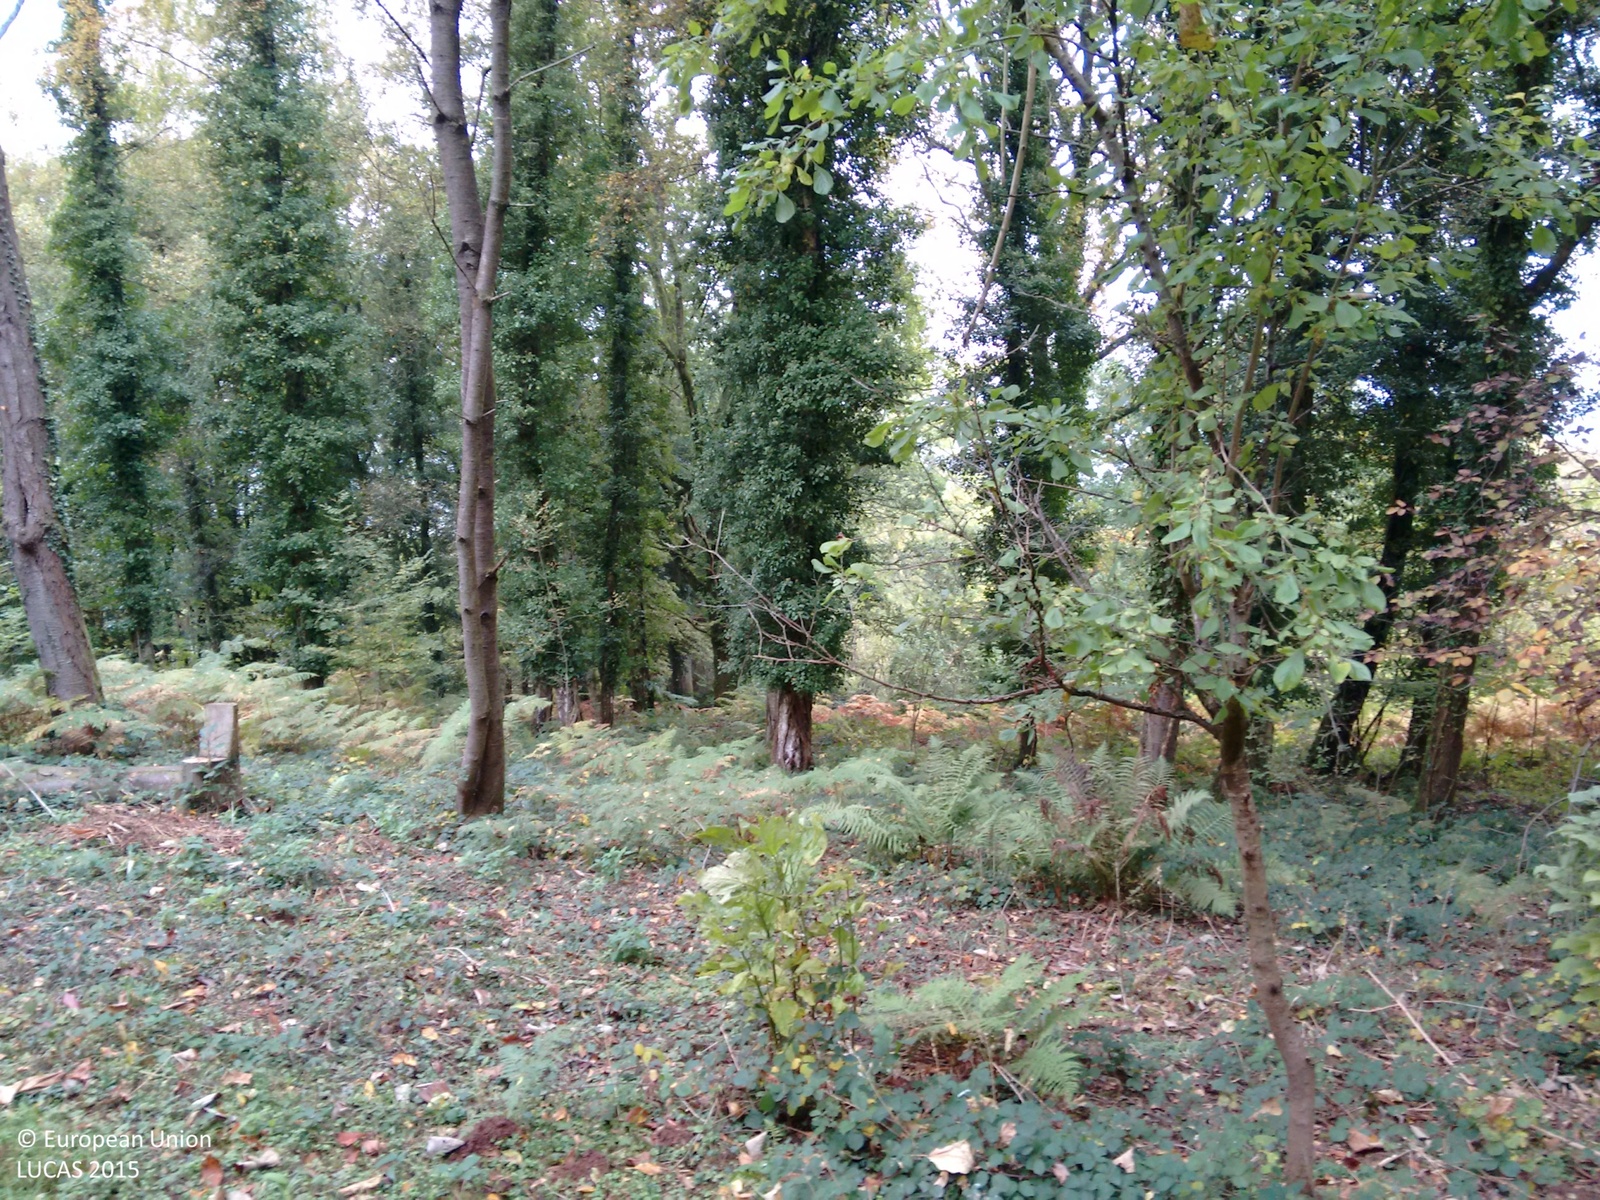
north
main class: Woodland
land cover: Broadleaved woodland
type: mesophytic deciduous forest
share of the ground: > 75 %
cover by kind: broadleaved forest trees 60 %, shrubs 20 %, herbaceous plants 20 %
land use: Residential
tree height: > 5 m
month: October
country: GB
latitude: 51.7335
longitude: -2.6520
